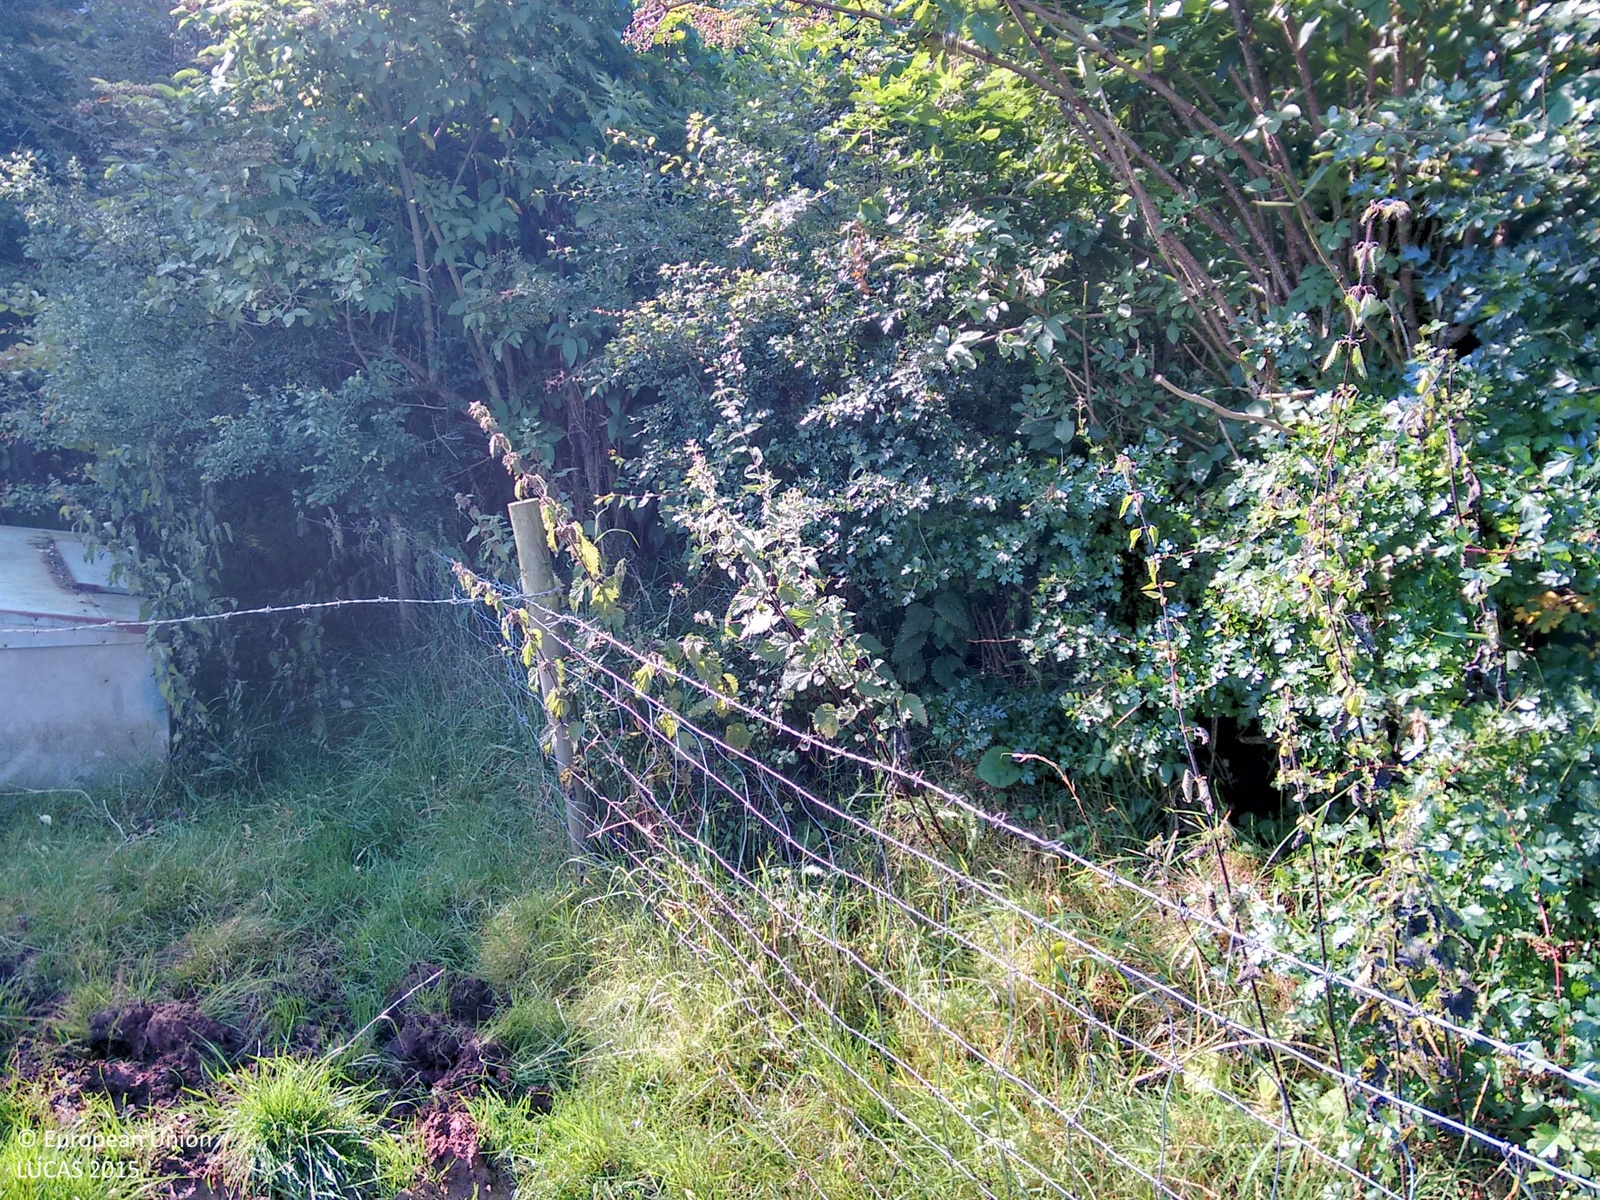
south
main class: Grassland
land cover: Grassland without tree/shrub cover
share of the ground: > 75 %
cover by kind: herbaceous plants 100 %
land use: Agriculture (excluding fallow land and kitchen gardens)
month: August
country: GB
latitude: 54.8063
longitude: -3.2224
